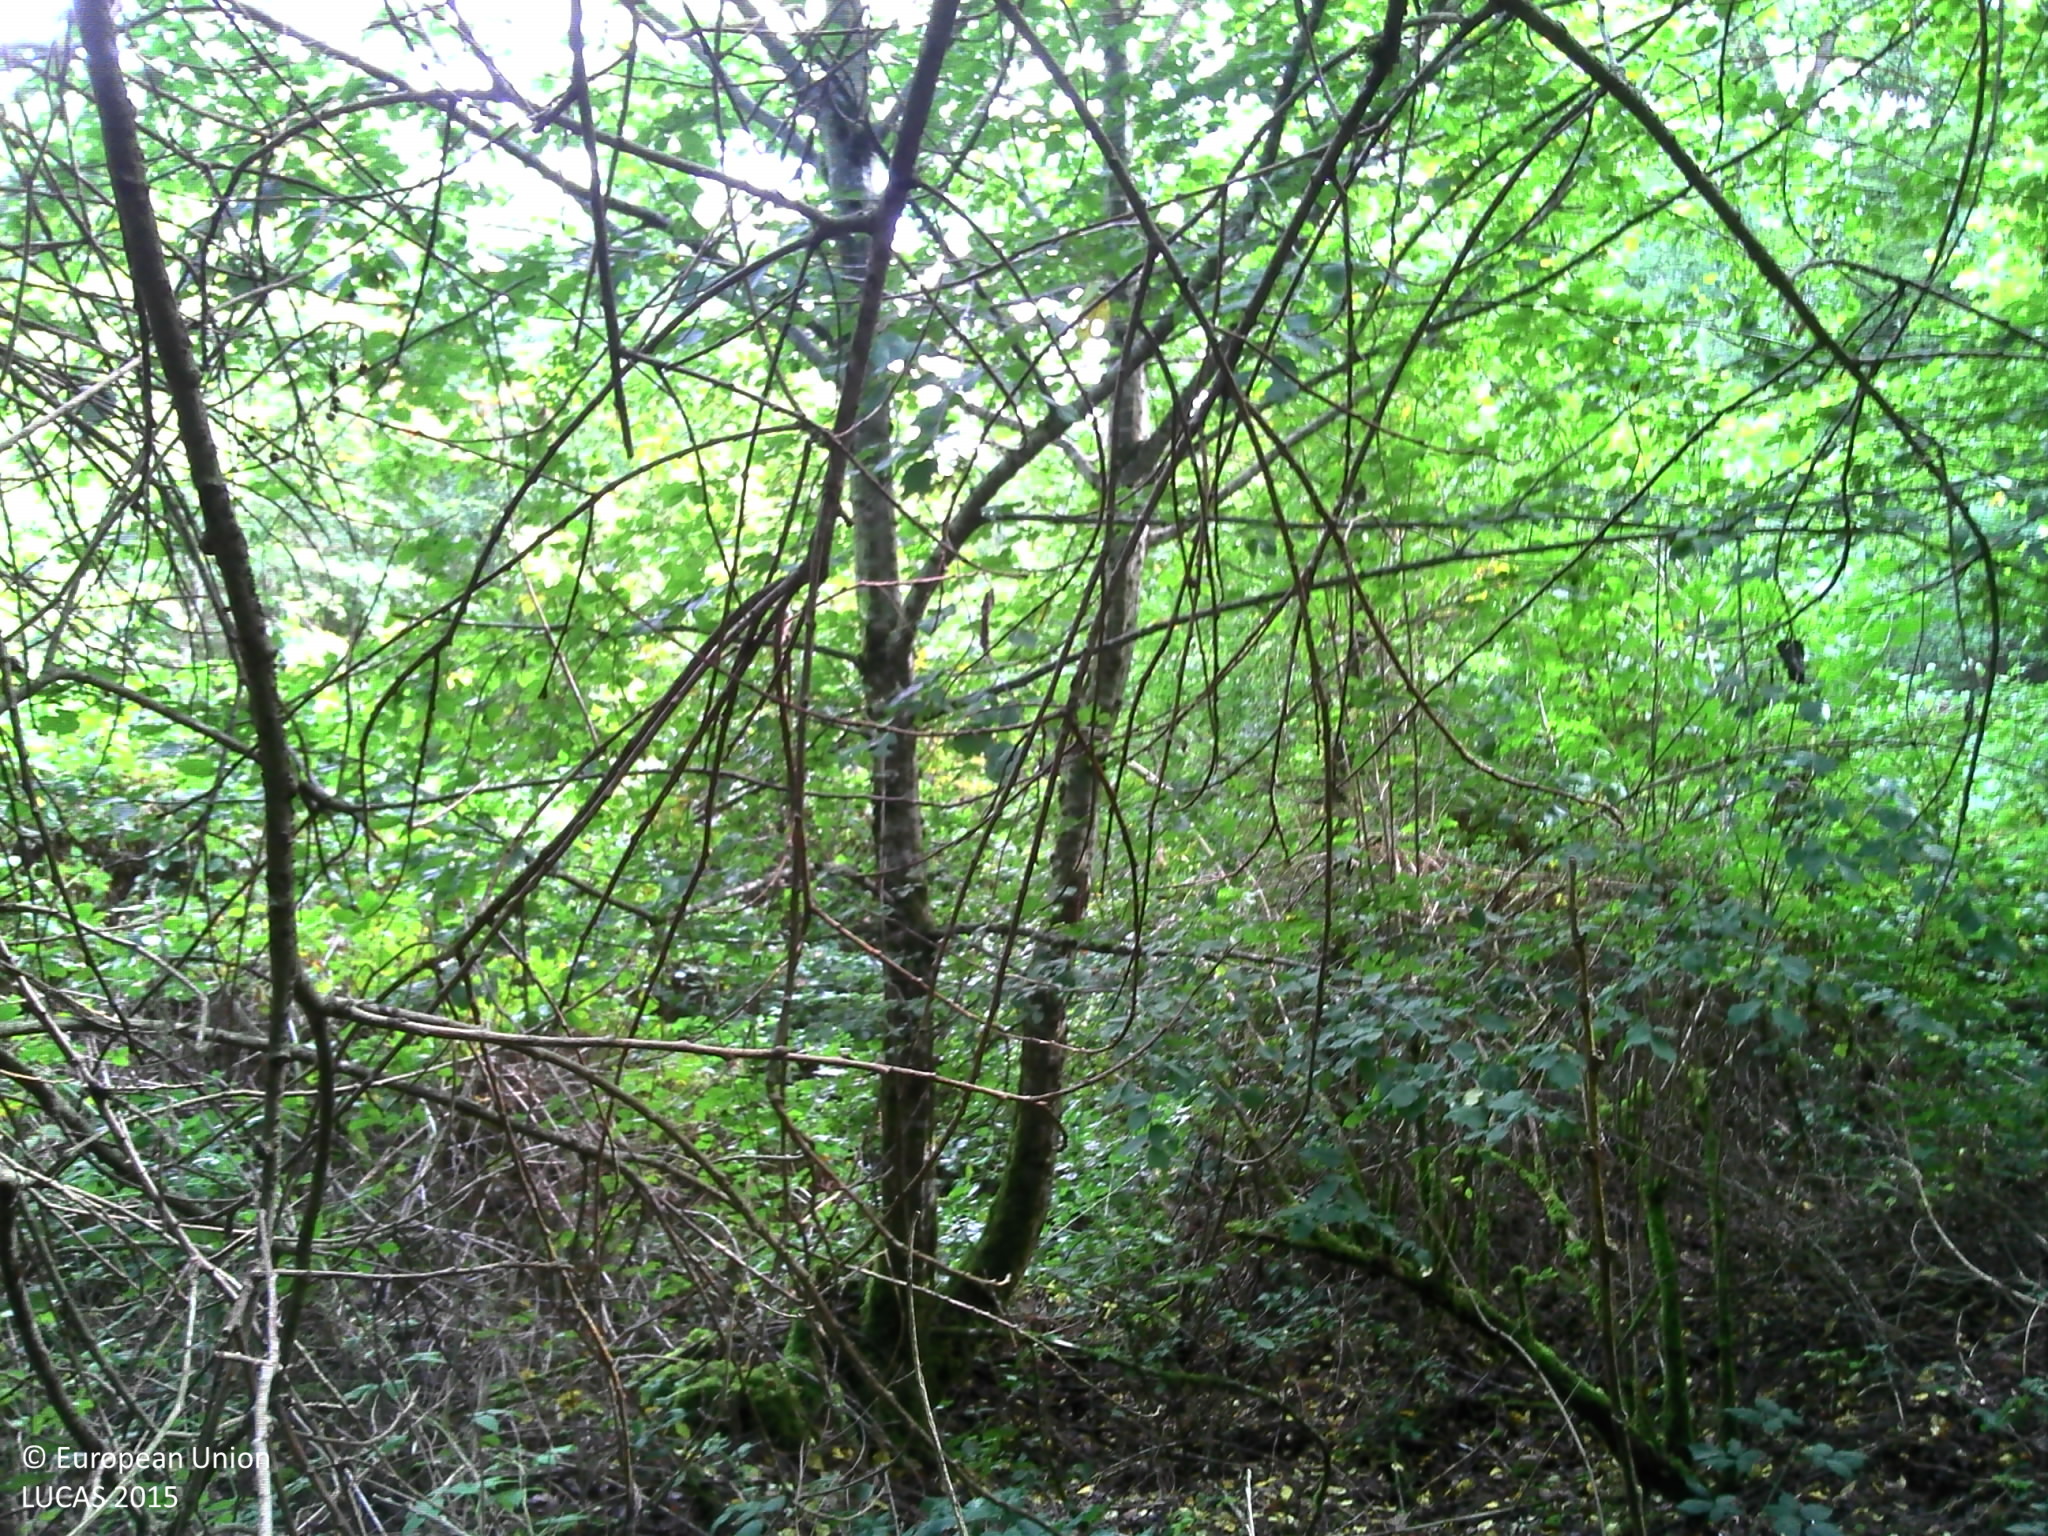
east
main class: Woodland
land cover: Broadleaved woodland
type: mesophytic deciduous forest
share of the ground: > 75 %
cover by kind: broadleaved forest trees 85 %, shrubs 15 %
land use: Forestry
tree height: > 5 m
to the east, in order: Broadleaved woodland
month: September
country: FR
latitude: 47.3016
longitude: 4.3253
